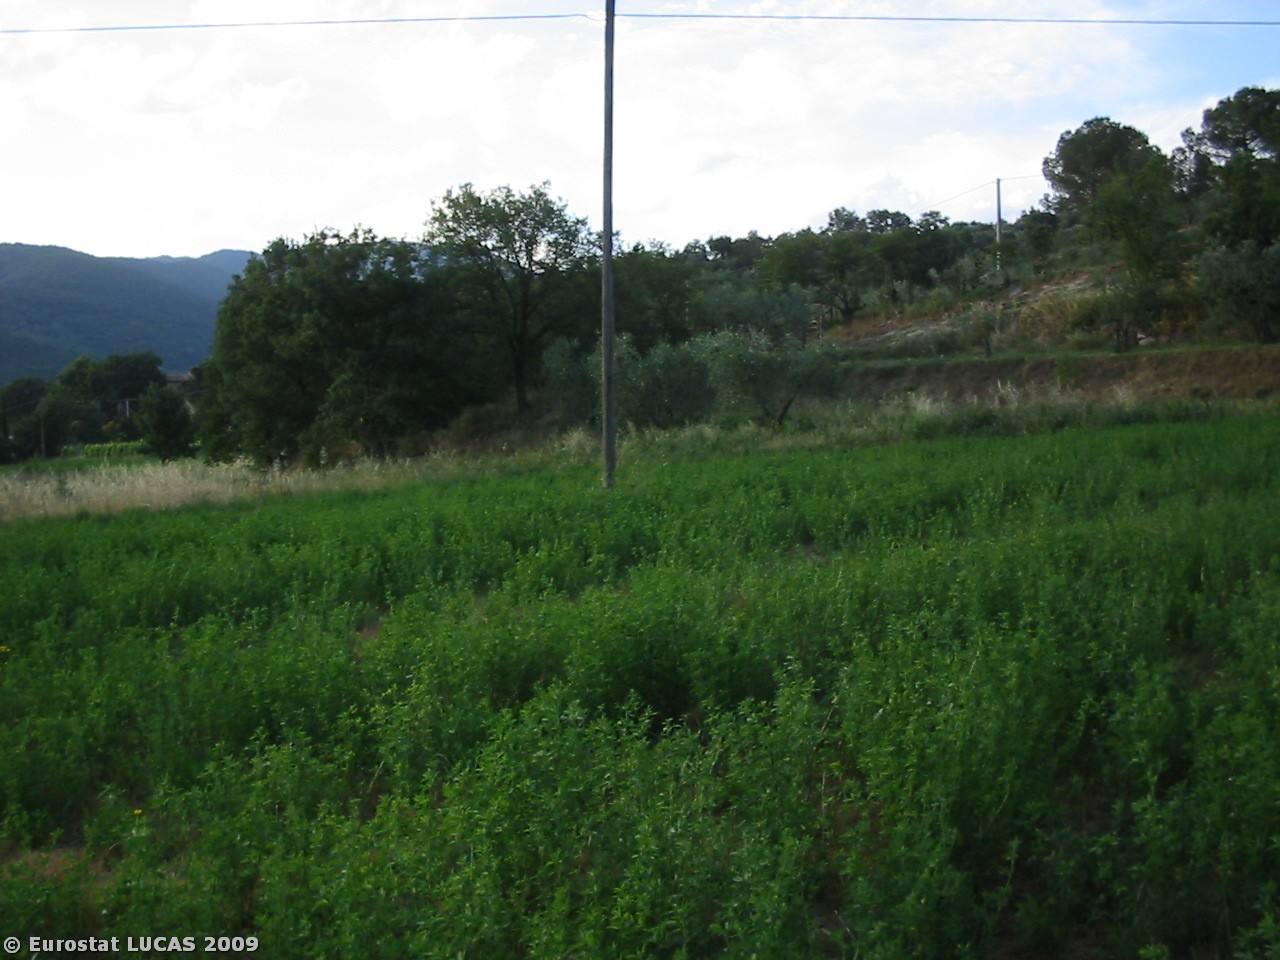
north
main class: Cropland
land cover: Lucerne
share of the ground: > 75 %
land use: Agriculture (excluding fallow land and kitchen gardens)
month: June
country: IT
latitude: 43.2474
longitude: 12.0510
